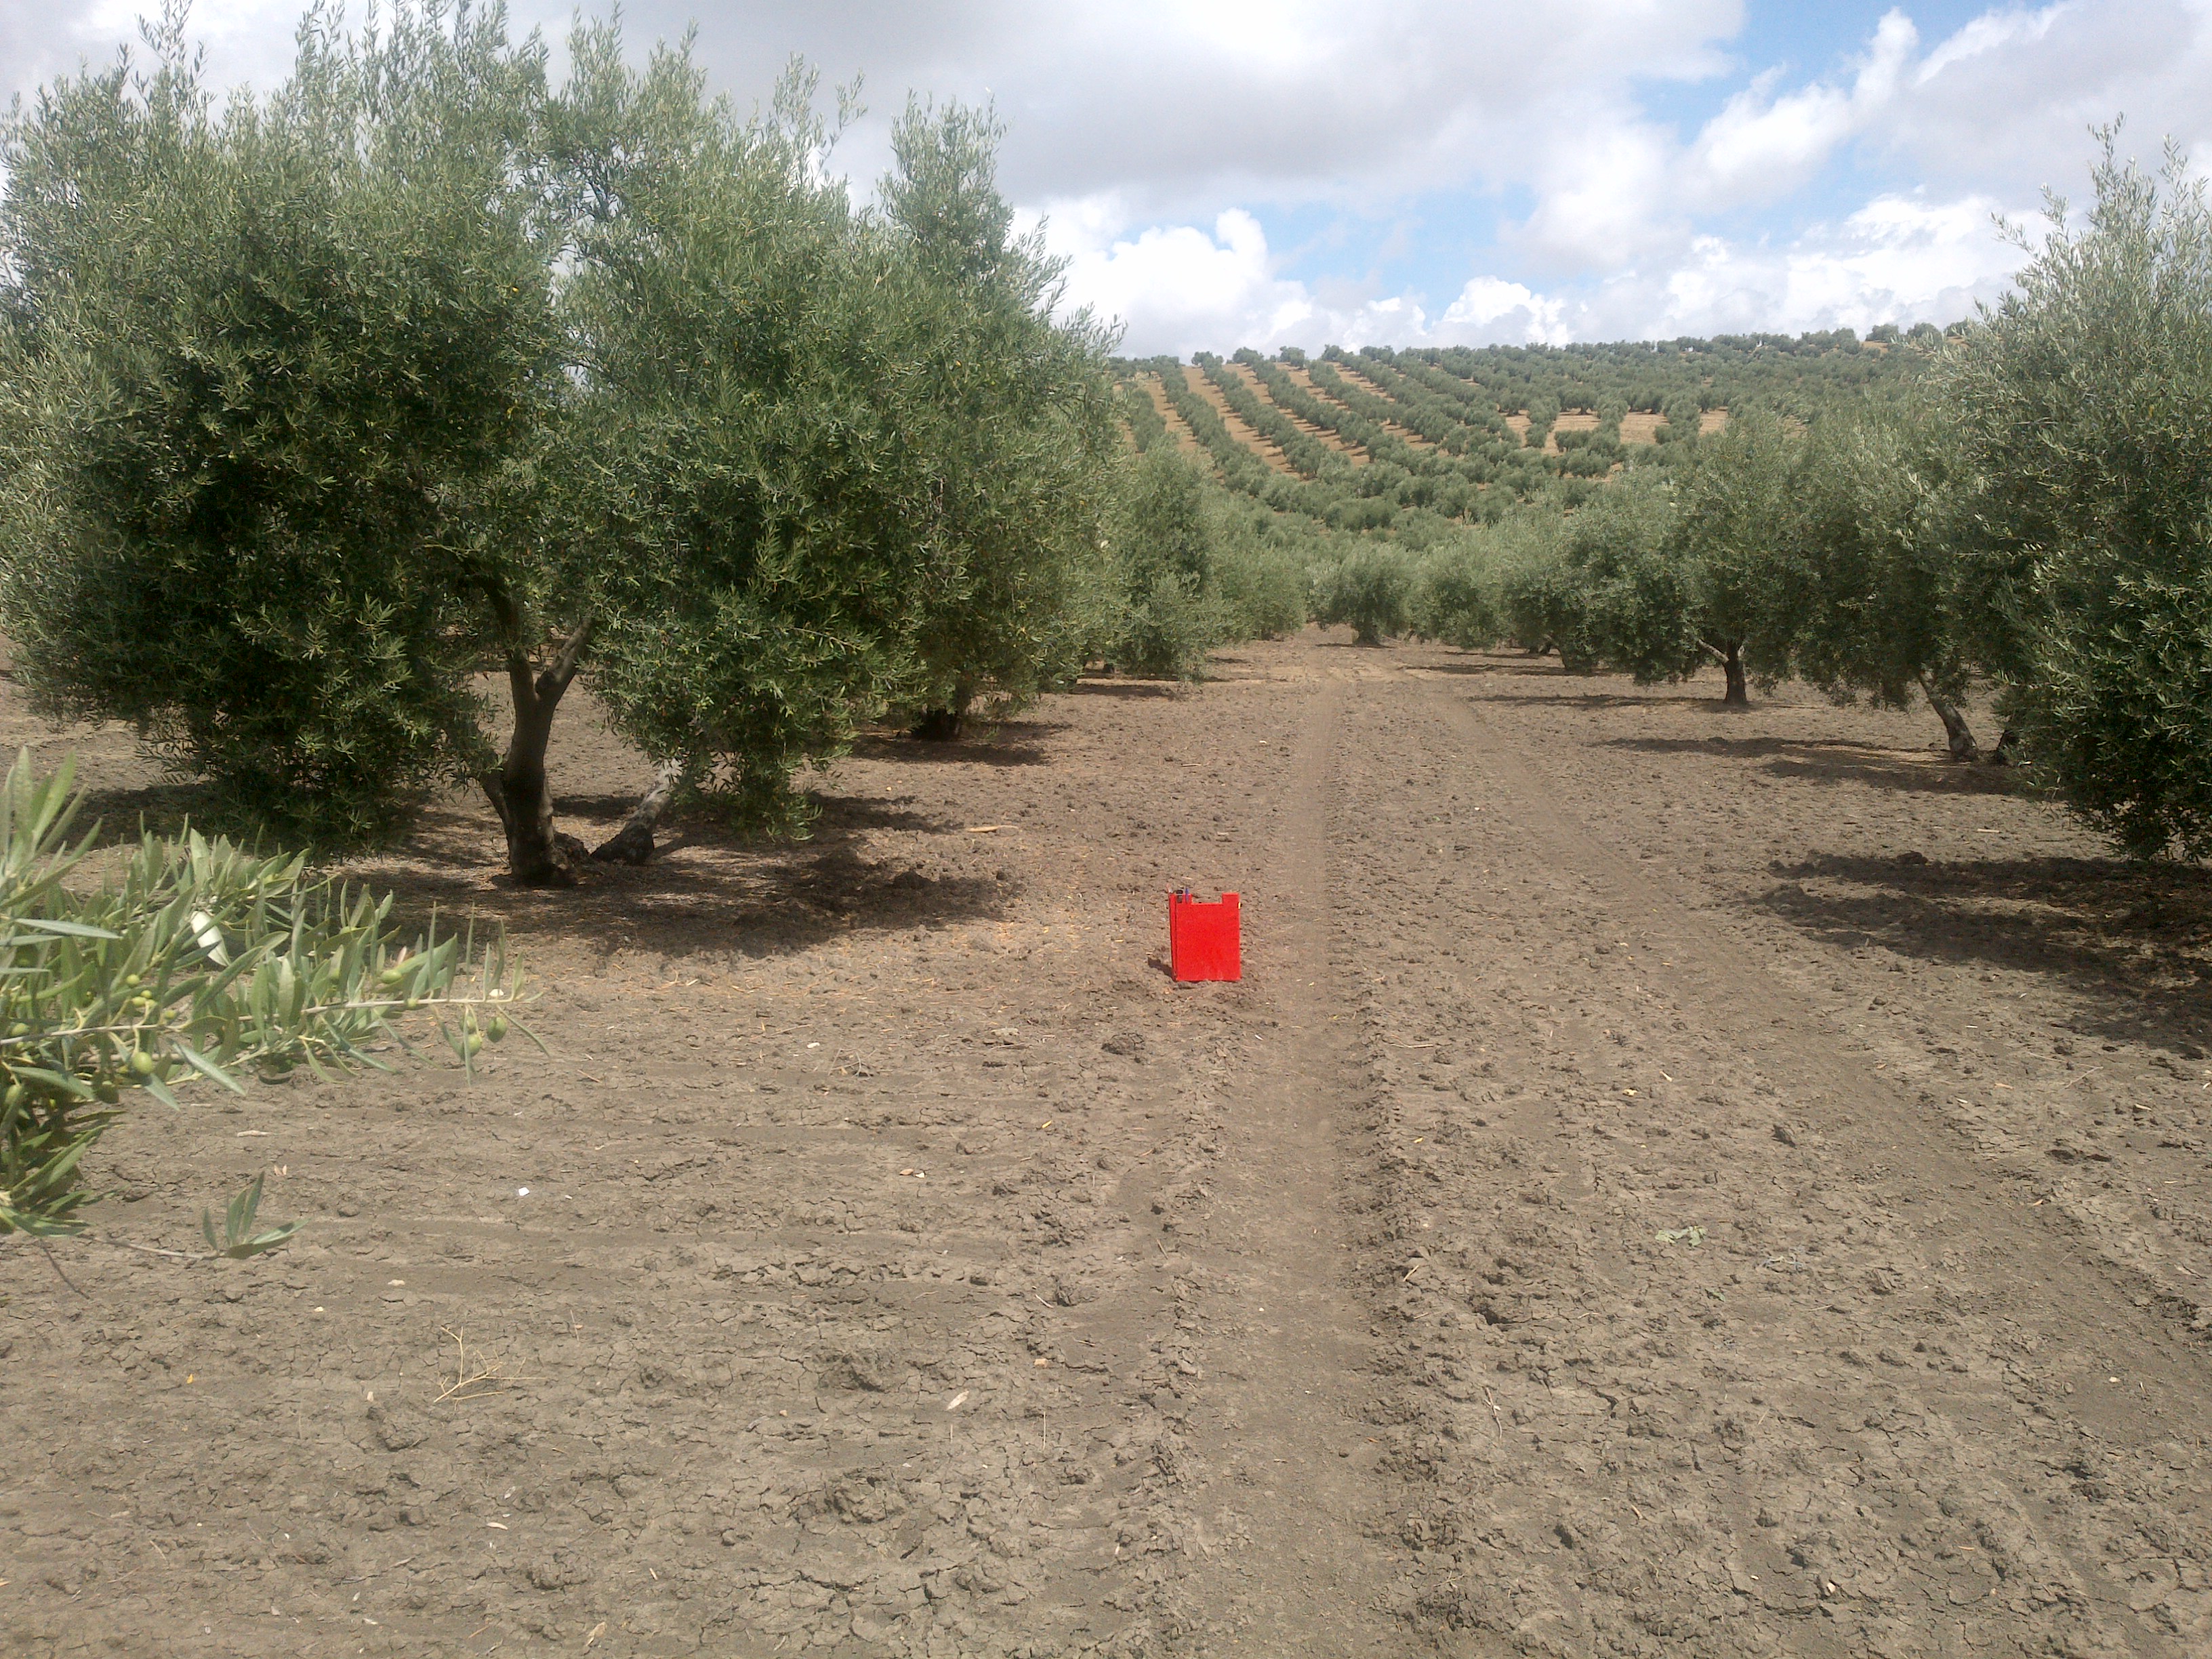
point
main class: Cropland
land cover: Olive groves
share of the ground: 50 - 75 %
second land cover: Other bare soil
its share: > 75 %
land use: Agriculture (excluding fallow land and kitchen gardens)
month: June
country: ES
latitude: 37.8596
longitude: -4.2722
